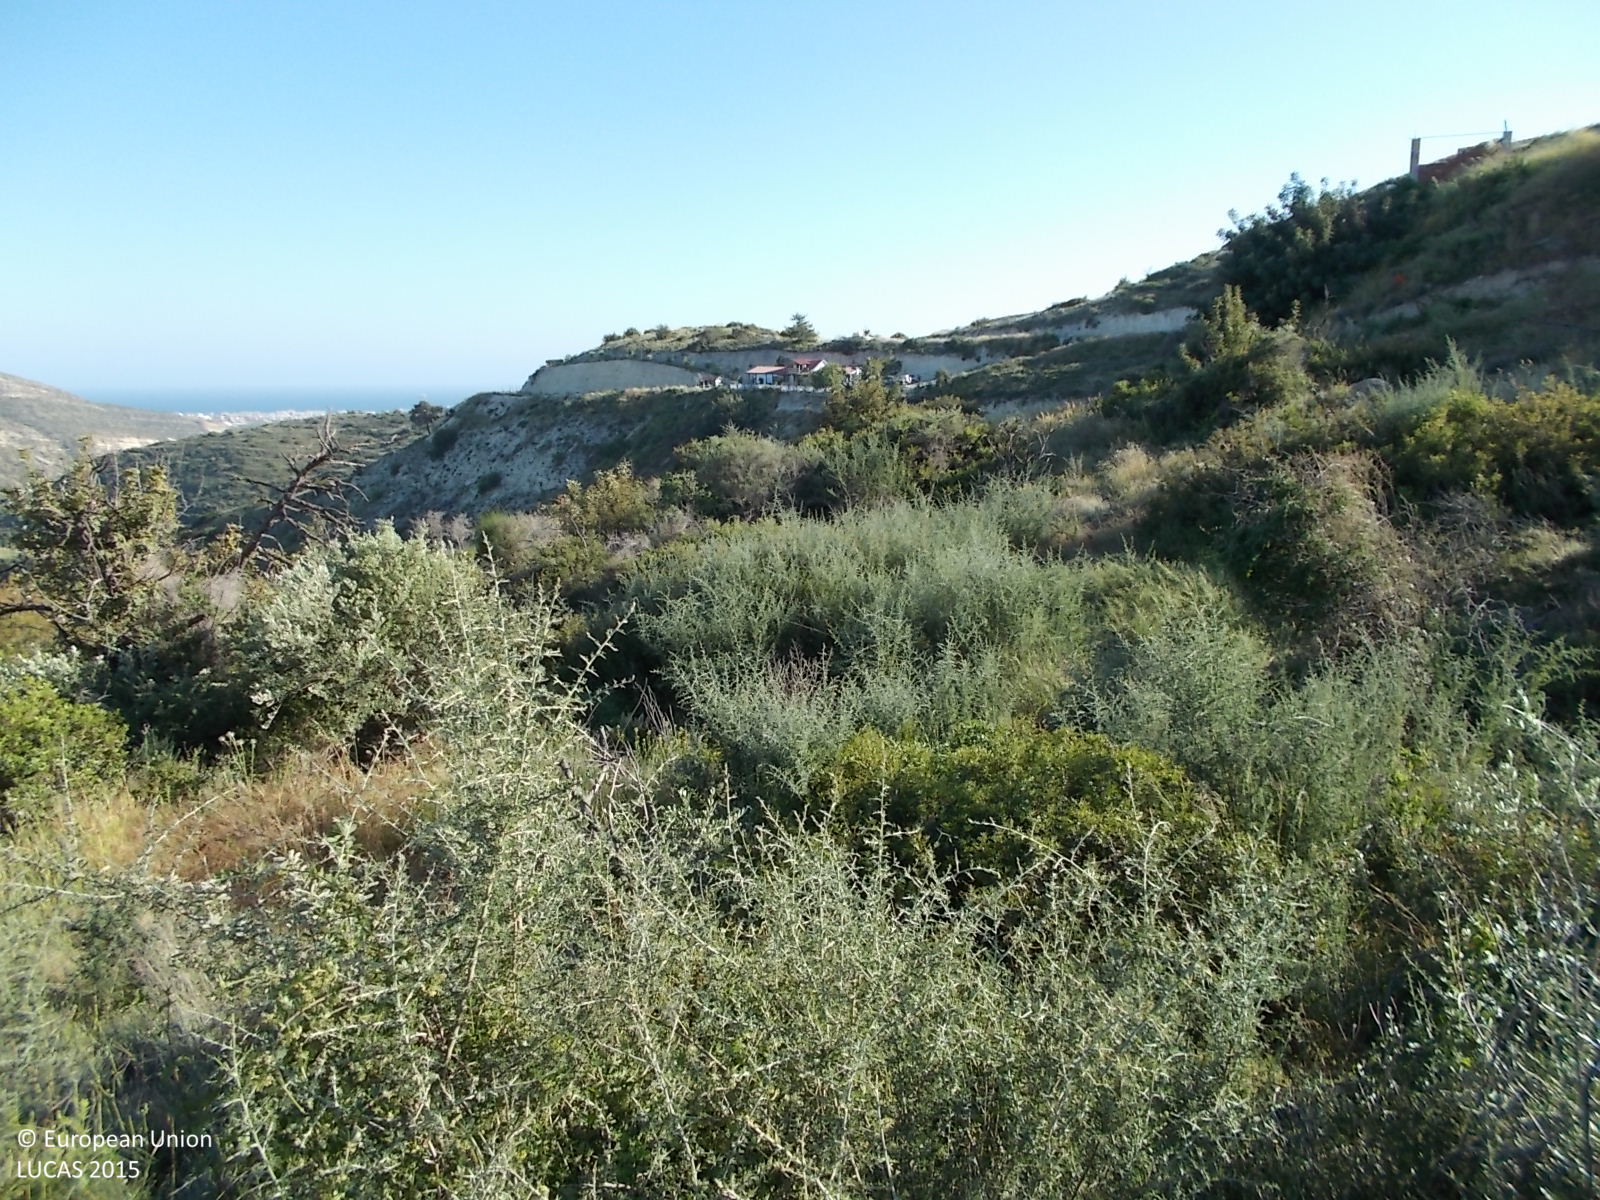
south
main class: Shrubland
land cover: Shrubland without tree cover
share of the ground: 50 - 75 %
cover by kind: shrubs 60 %, herbaceous plants 35 %, consolidated bare surface 5 %
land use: Semi-natural and natural areas not in use
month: April
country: CY
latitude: 34.7555
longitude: 33.0770
